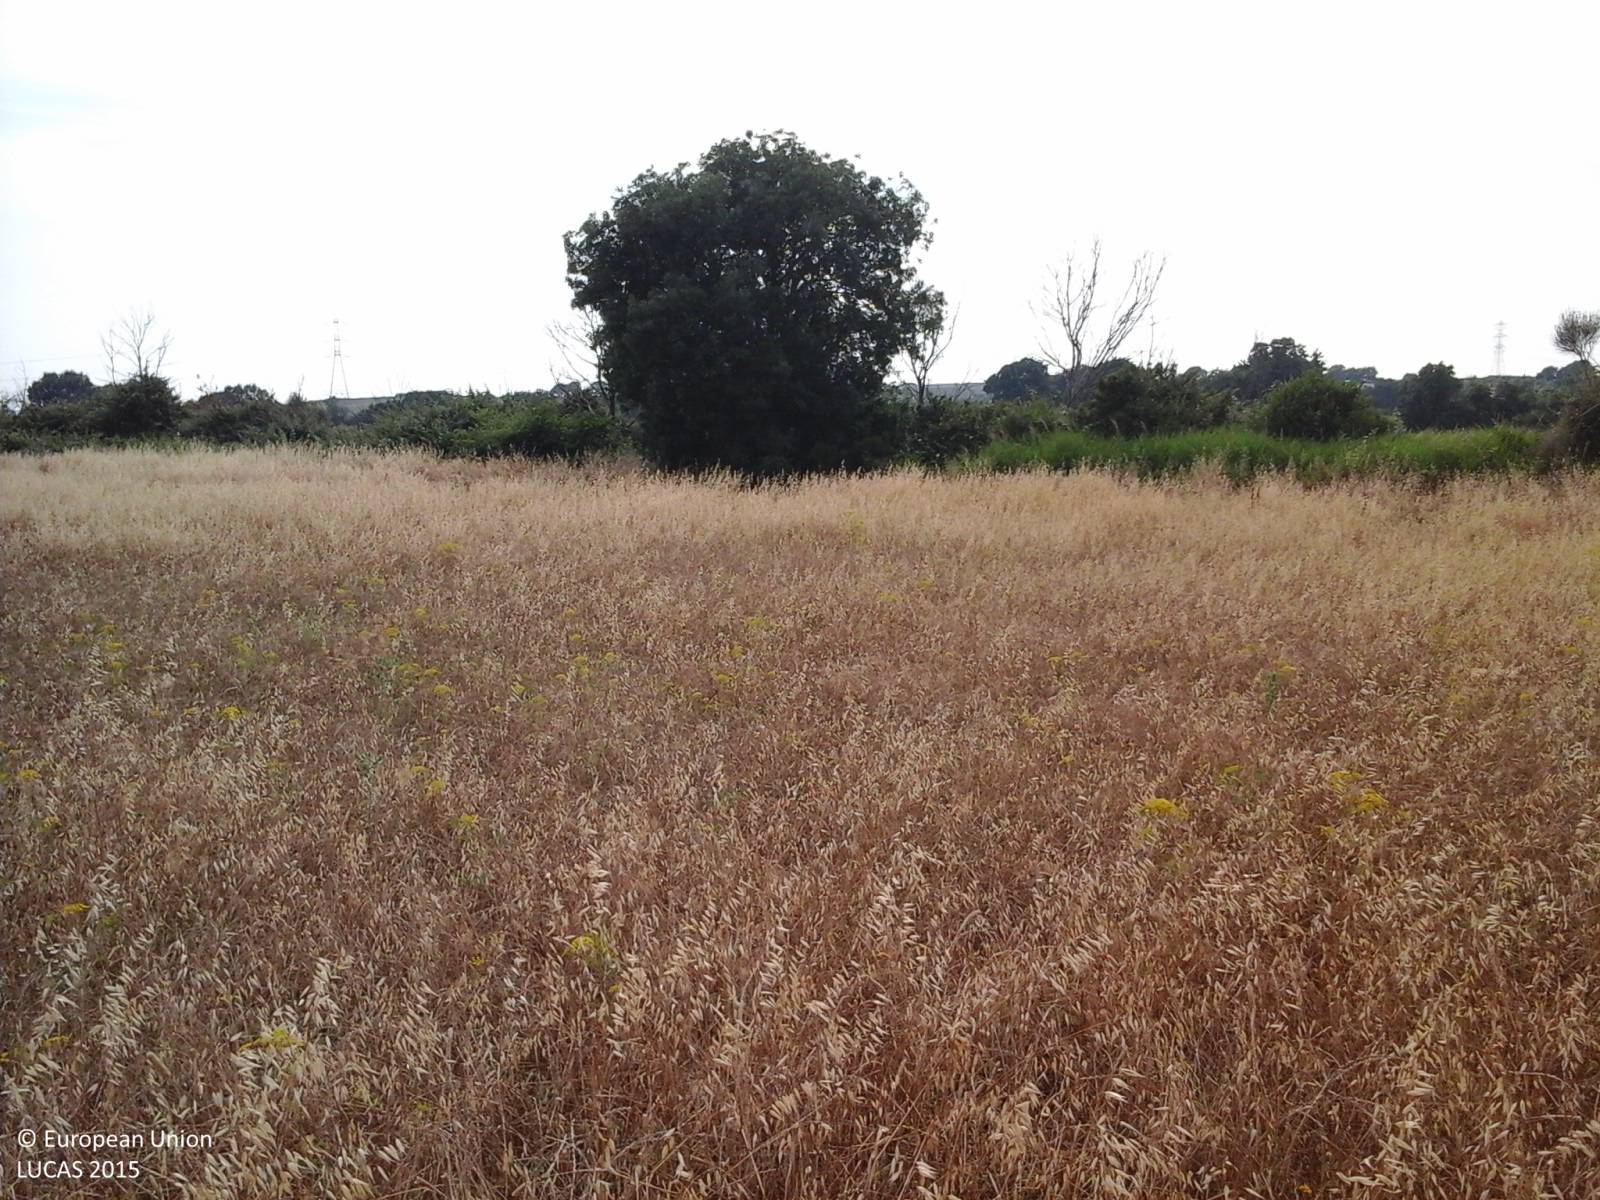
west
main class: Cropland
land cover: Oats
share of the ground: > 75 %
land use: Agriculture (excluding fallow land and kitchen gardens)
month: June
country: IT
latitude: 42.3887
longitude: 11.5857
